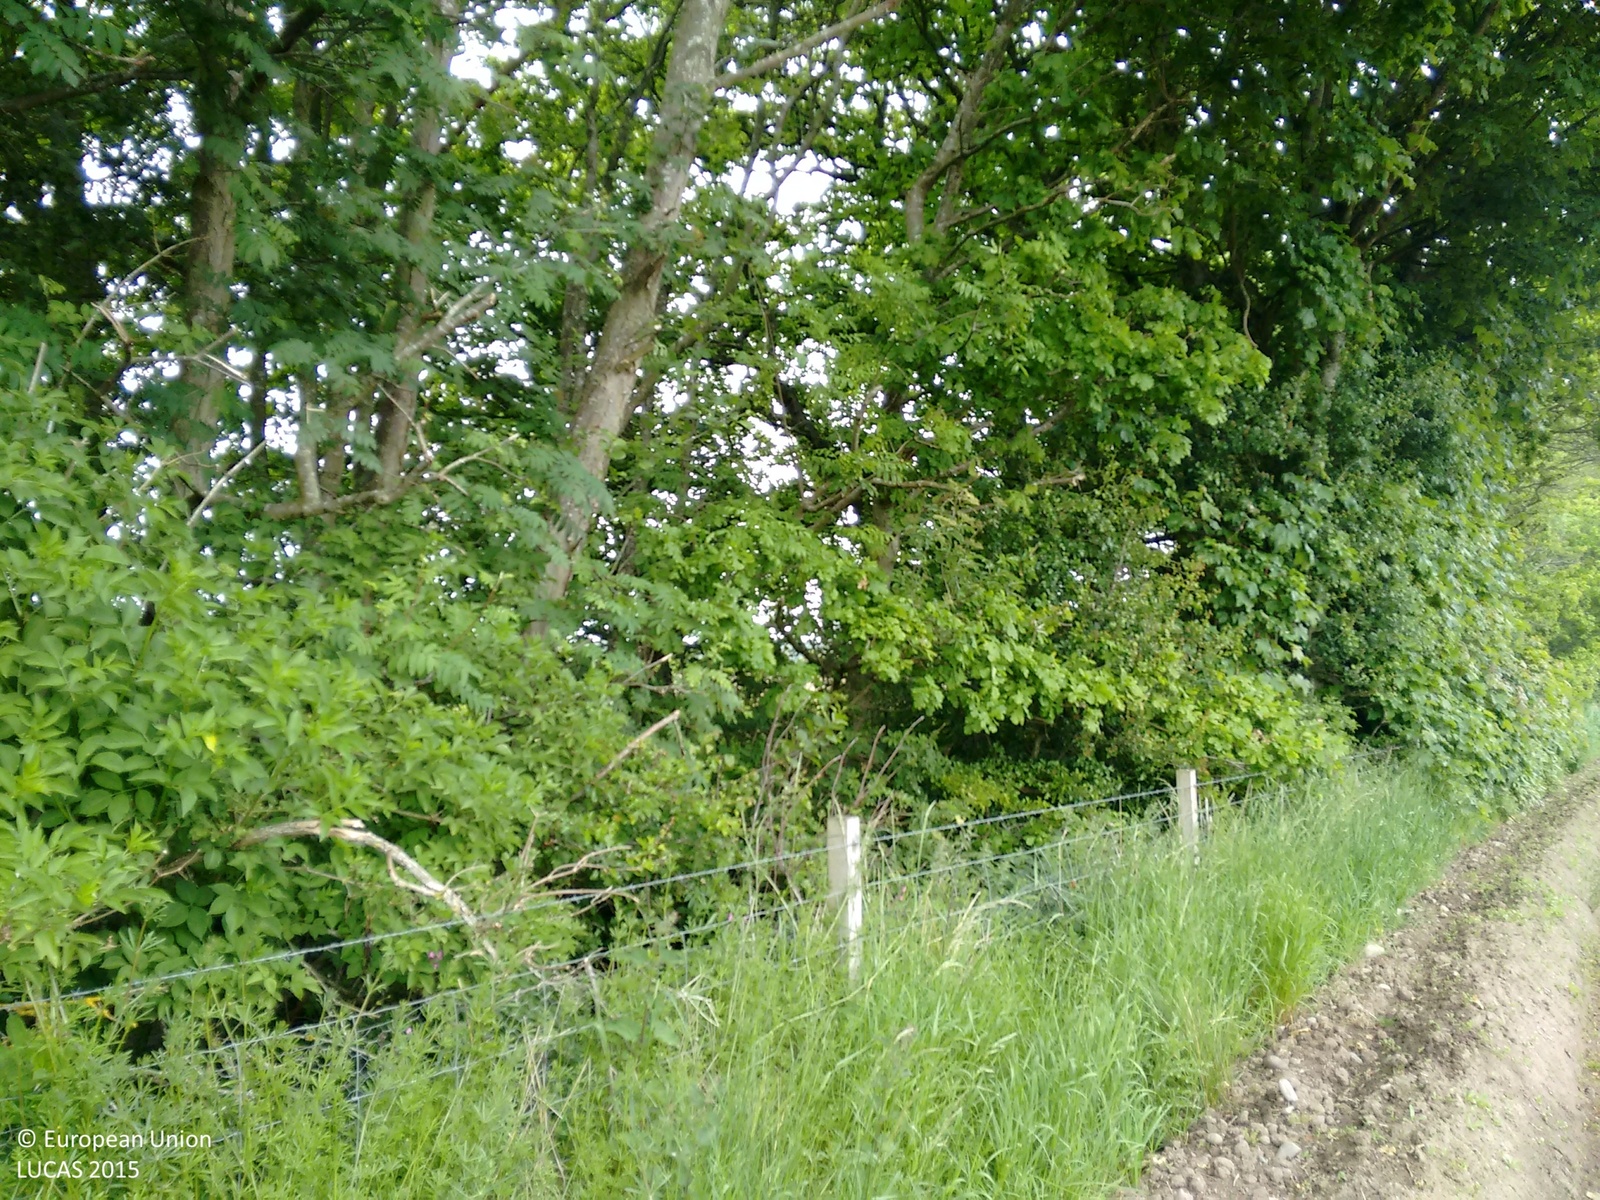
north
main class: Cropland
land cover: Potatoes
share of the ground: < 10 %
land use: Agriculture (excluding fallow land and kitchen gardens)
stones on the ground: 10 - 25 %
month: June
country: GB
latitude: 56.4600
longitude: -3.4628
